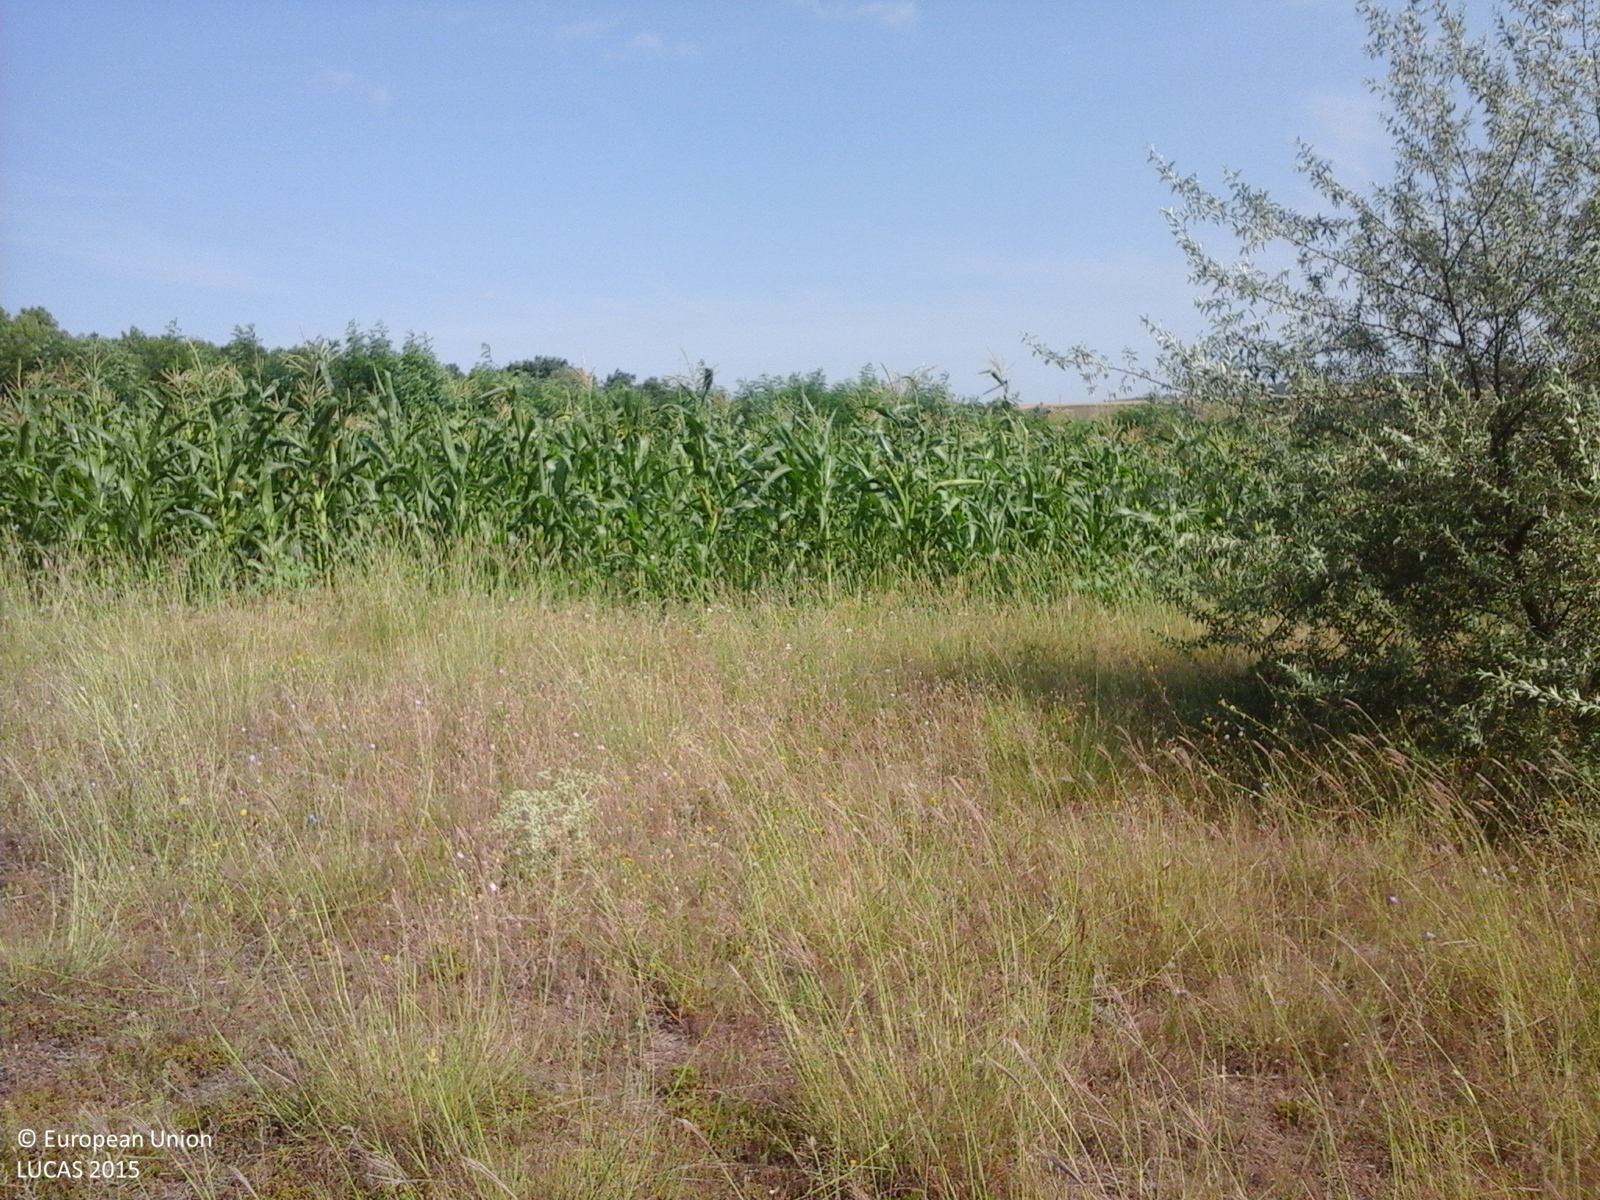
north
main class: Grassland
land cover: Grassland with sparse tree/shrub cover
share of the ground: > 75 %
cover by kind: herbaceous plants 95 %, broadleaved forest trees 5 %
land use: Agriculture (excluding fallow land and kitchen gardens)
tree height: > 5 m
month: July
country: RO
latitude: 46.0525
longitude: 27.8372
